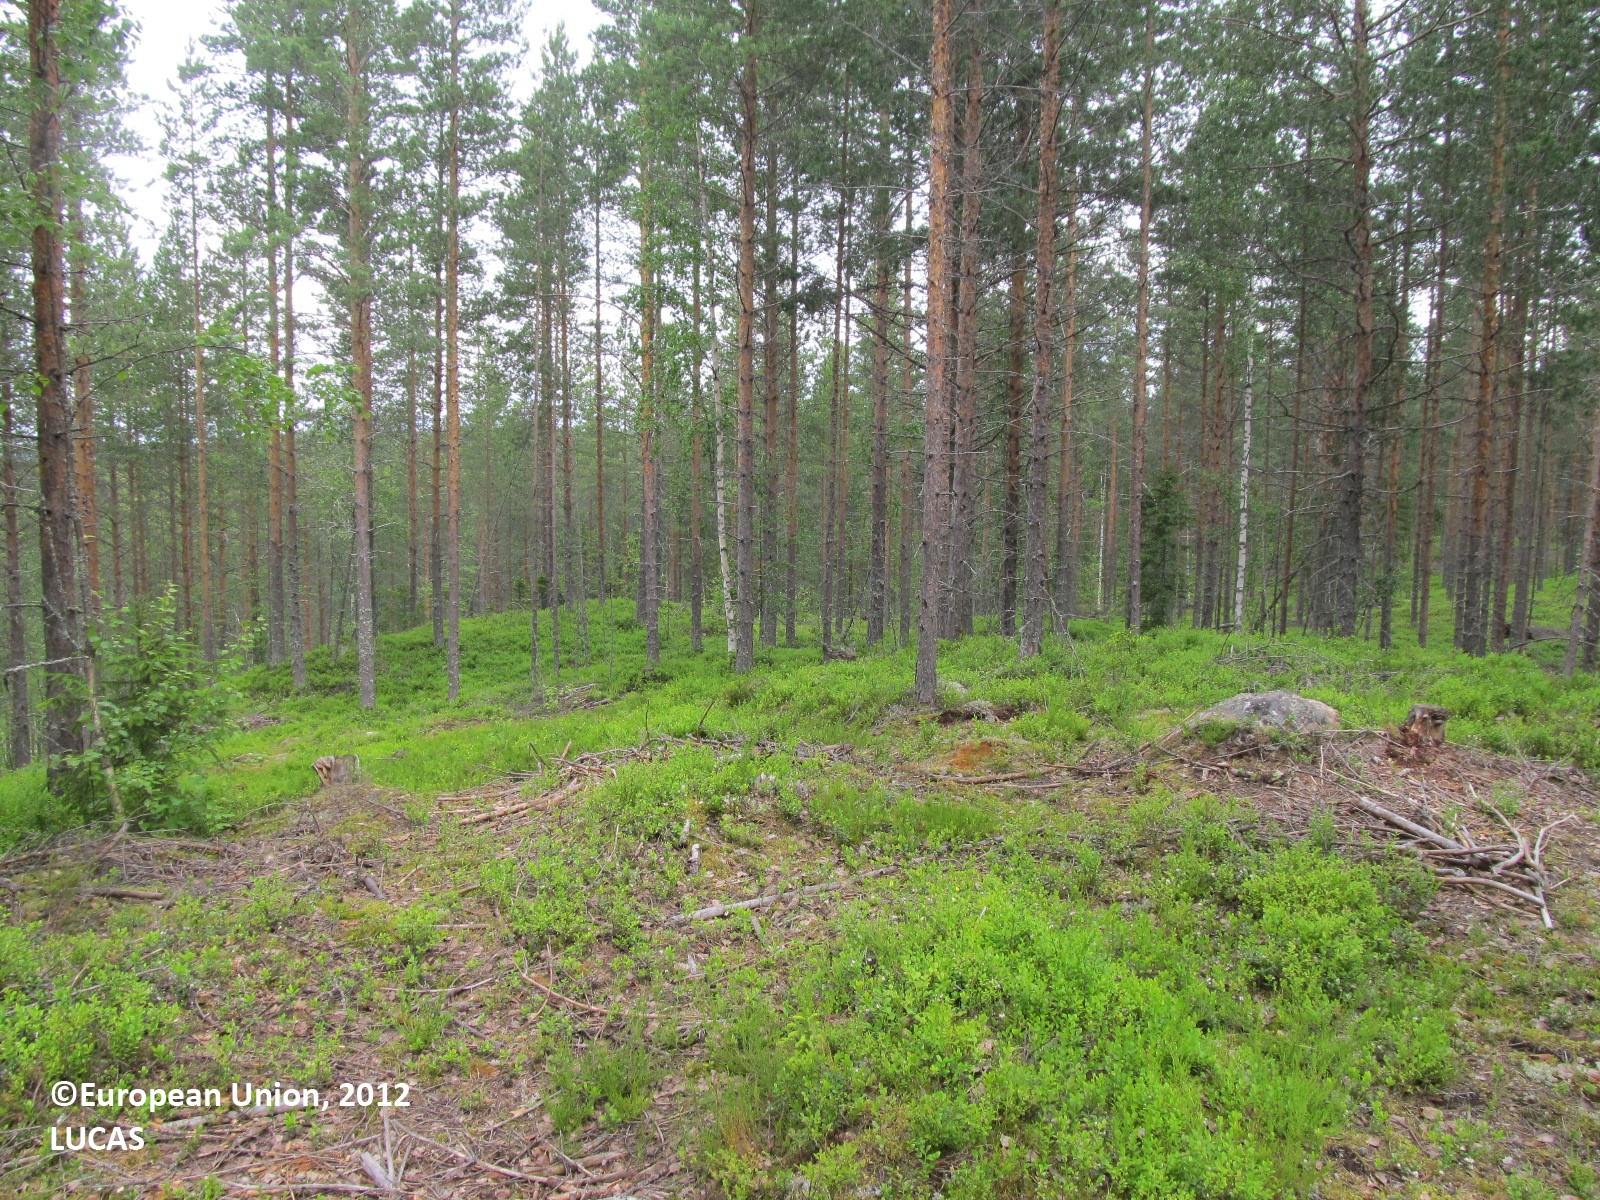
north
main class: Woodland
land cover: Pine dominated coniferous woodland
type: boreal forest
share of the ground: 50 - 75 %
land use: Forestry
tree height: > 5 m
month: June
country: FI
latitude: 62.8403
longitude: 28.8450
